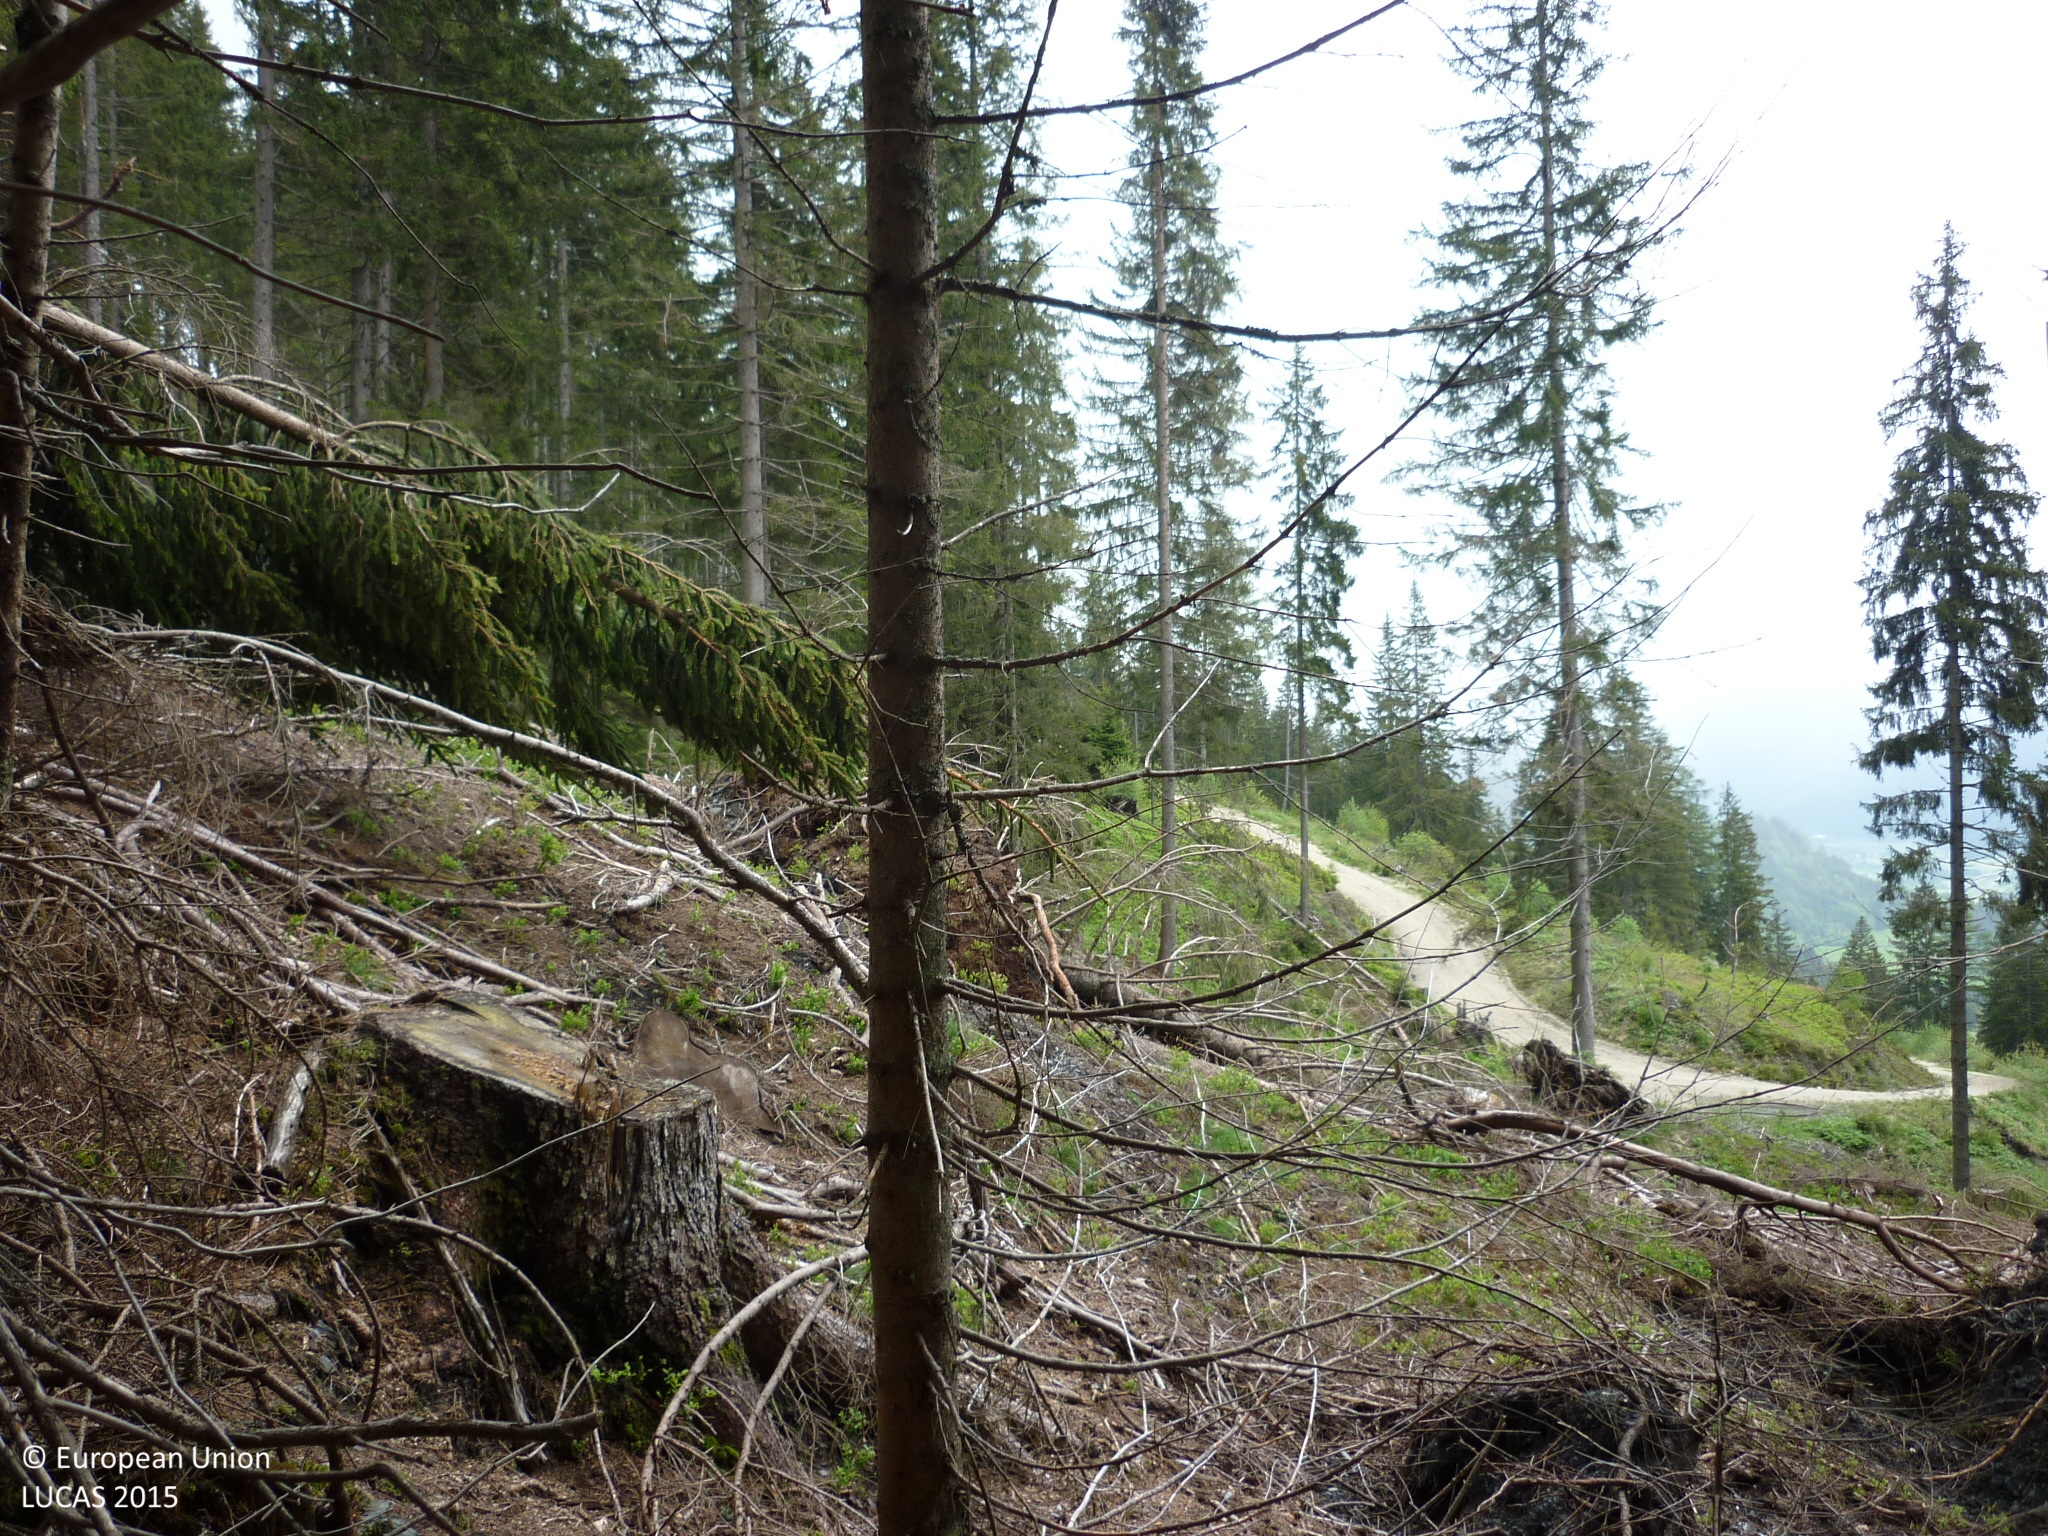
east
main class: Woodland
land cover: Spruce dominated coniferous woodland
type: alpine coniferous forest
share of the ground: > 75 %
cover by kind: coniferous forest trees 85 %, broadleaved forest trees 5 %, herbaceous plants 5 %, lichens and mosses 5 %
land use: Forestry
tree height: > 5 m
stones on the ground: 10 - 25 %
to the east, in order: Spruce dominated coniferous woodland; Spontaneously vegetated surfaces; Rivers and streams; Spontaneously vegetated surfaces; Spruce dominated coniferous woodland; Grassland with sparse tree/shrub cover; Spruce dominated coniferous woodland; Rivers and streams; Spruce dominated coniferous woodland; Shrubland with sparse tree cover
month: May
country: AT
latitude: 47.4560
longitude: 14.7081
